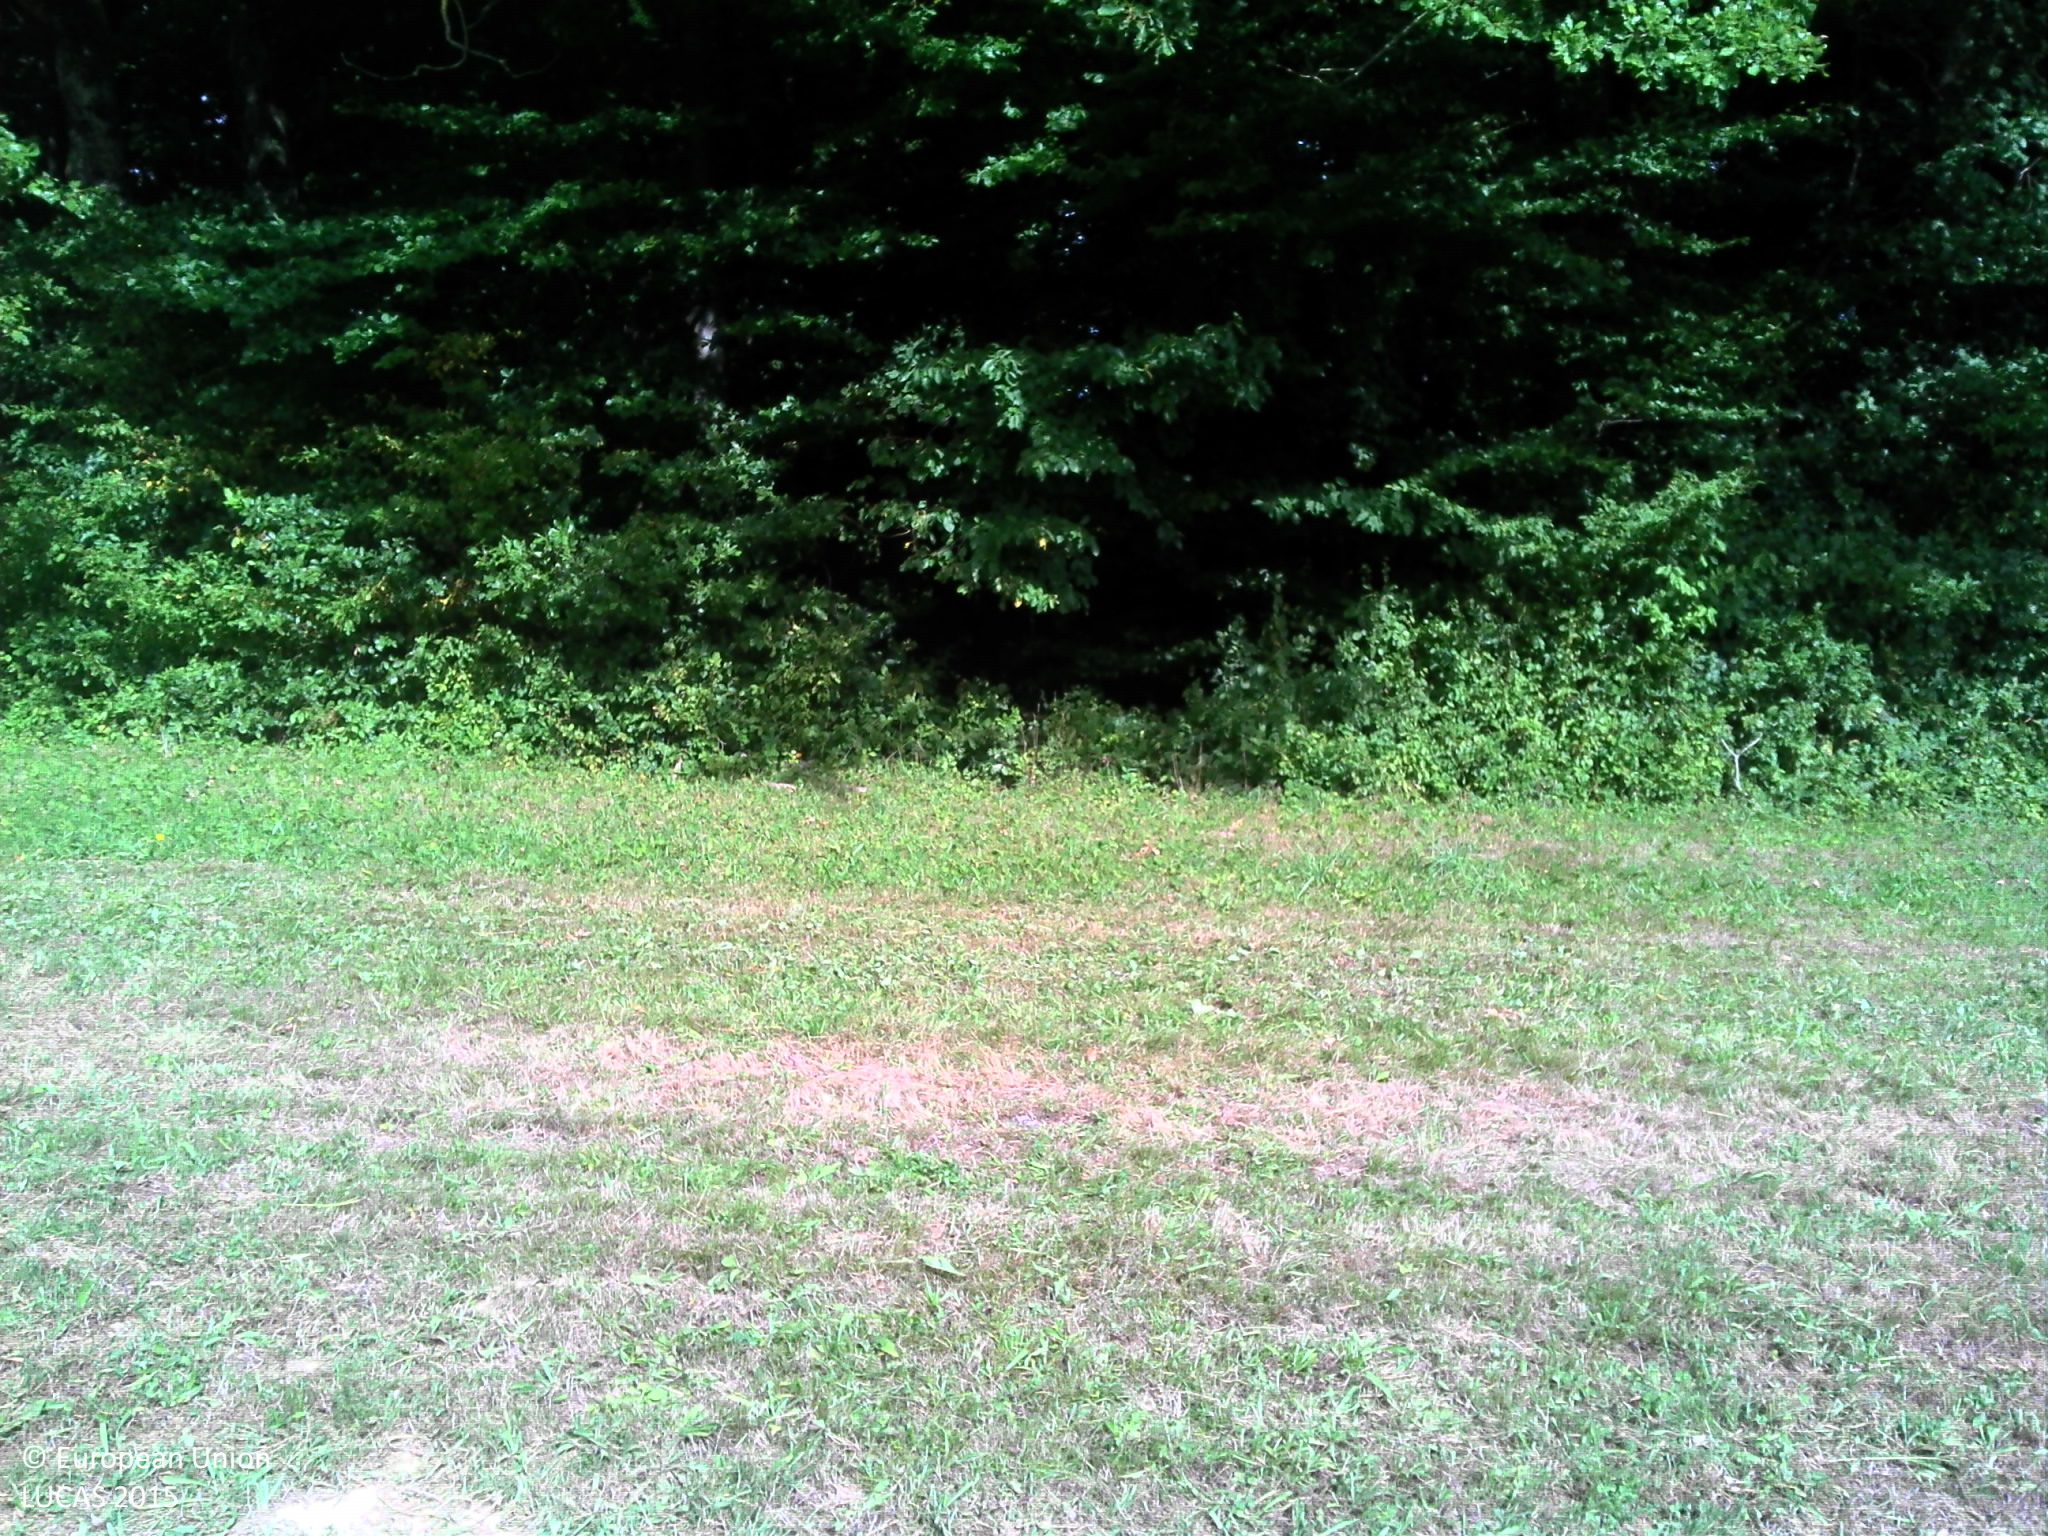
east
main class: Grassland
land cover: Grassland with sparse tree/shrub cover
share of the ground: > 75 %
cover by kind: herbaceous plants 95 %, broadleaved forest trees 5 %
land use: Agriculture (excluding fallow land and kitchen gardens)
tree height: > 5 m
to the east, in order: Grassland with sparse tree/shrub cover; Broadleaved woodland; Grassland without tree/shrub cover; Broadleaved woodland; Tracks; Broadleaved woodland
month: September
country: FR
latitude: 47.3455
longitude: 6.1498
